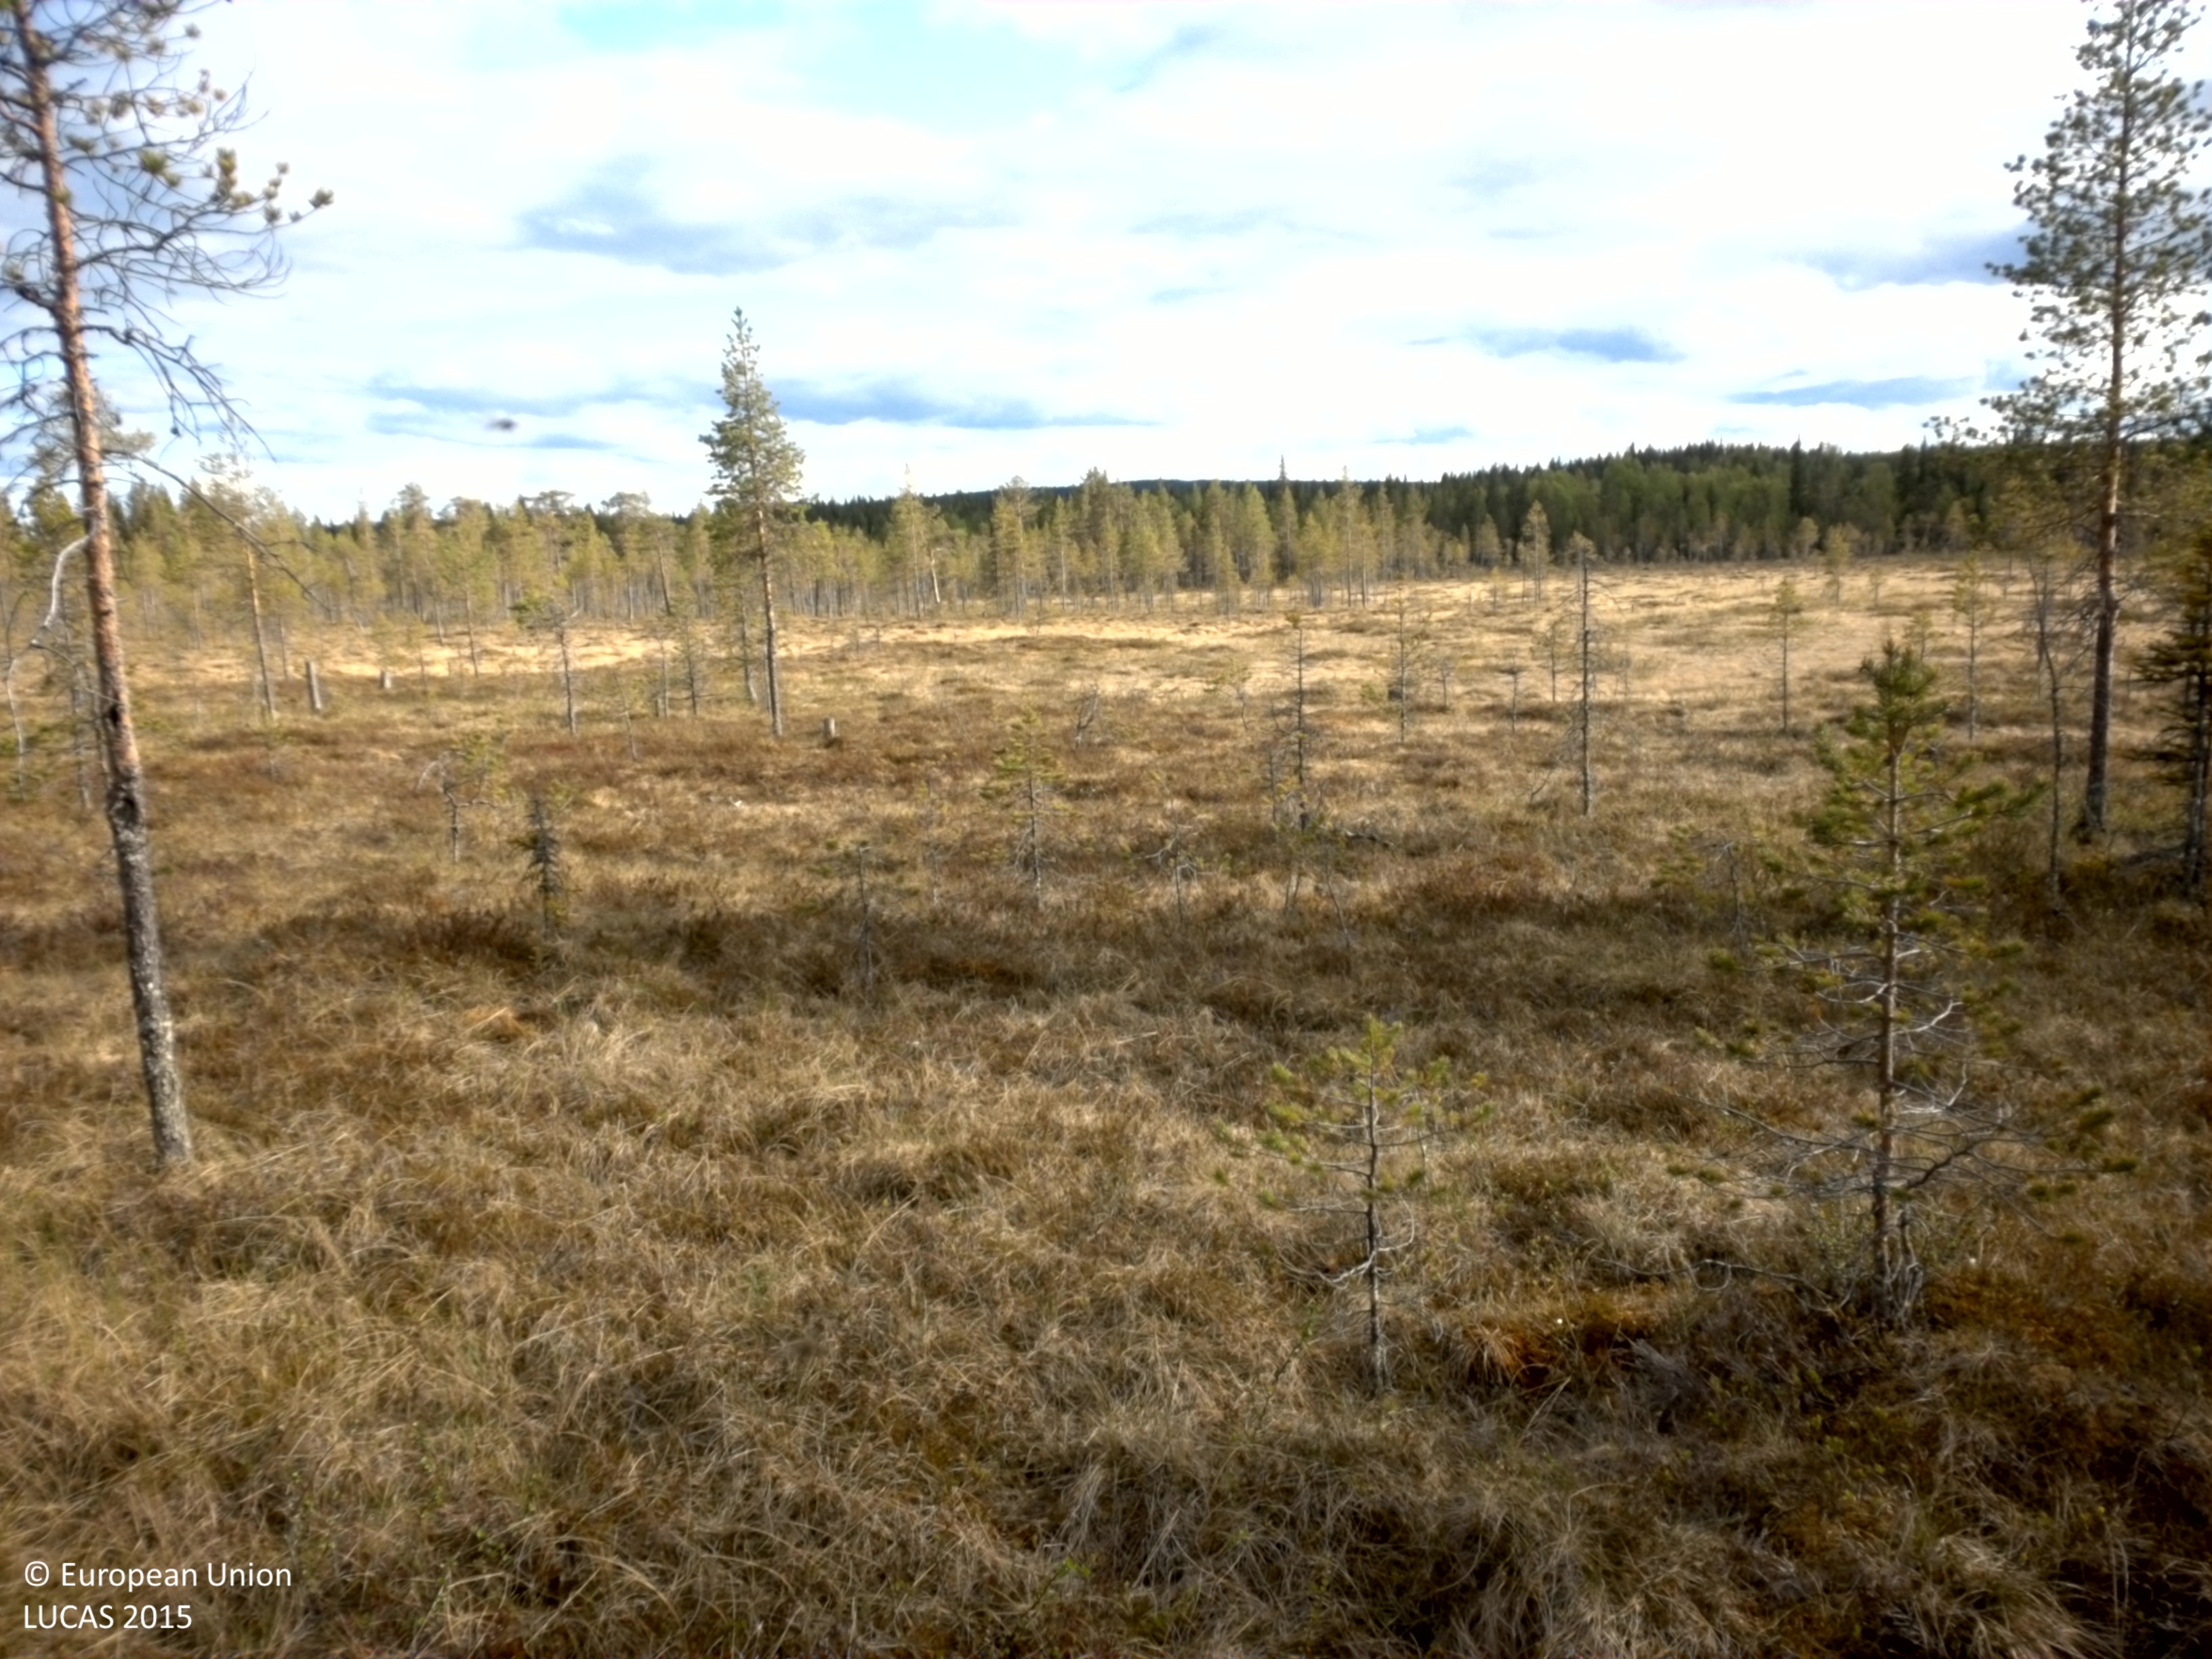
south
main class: Woodland
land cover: Pine dominated coniferous woodland
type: boreal forest
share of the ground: 25 - 50 %
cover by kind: herbaceous plants 45 %, coniferous forest trees 20 %, shrubs 15 %, lichens and mosses 10 %, broadleaved forest trees 5 %, unconsolidated bare surface 5 %
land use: Forestry
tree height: < 5 m
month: June
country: SE
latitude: 64.2052
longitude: 17.4459
